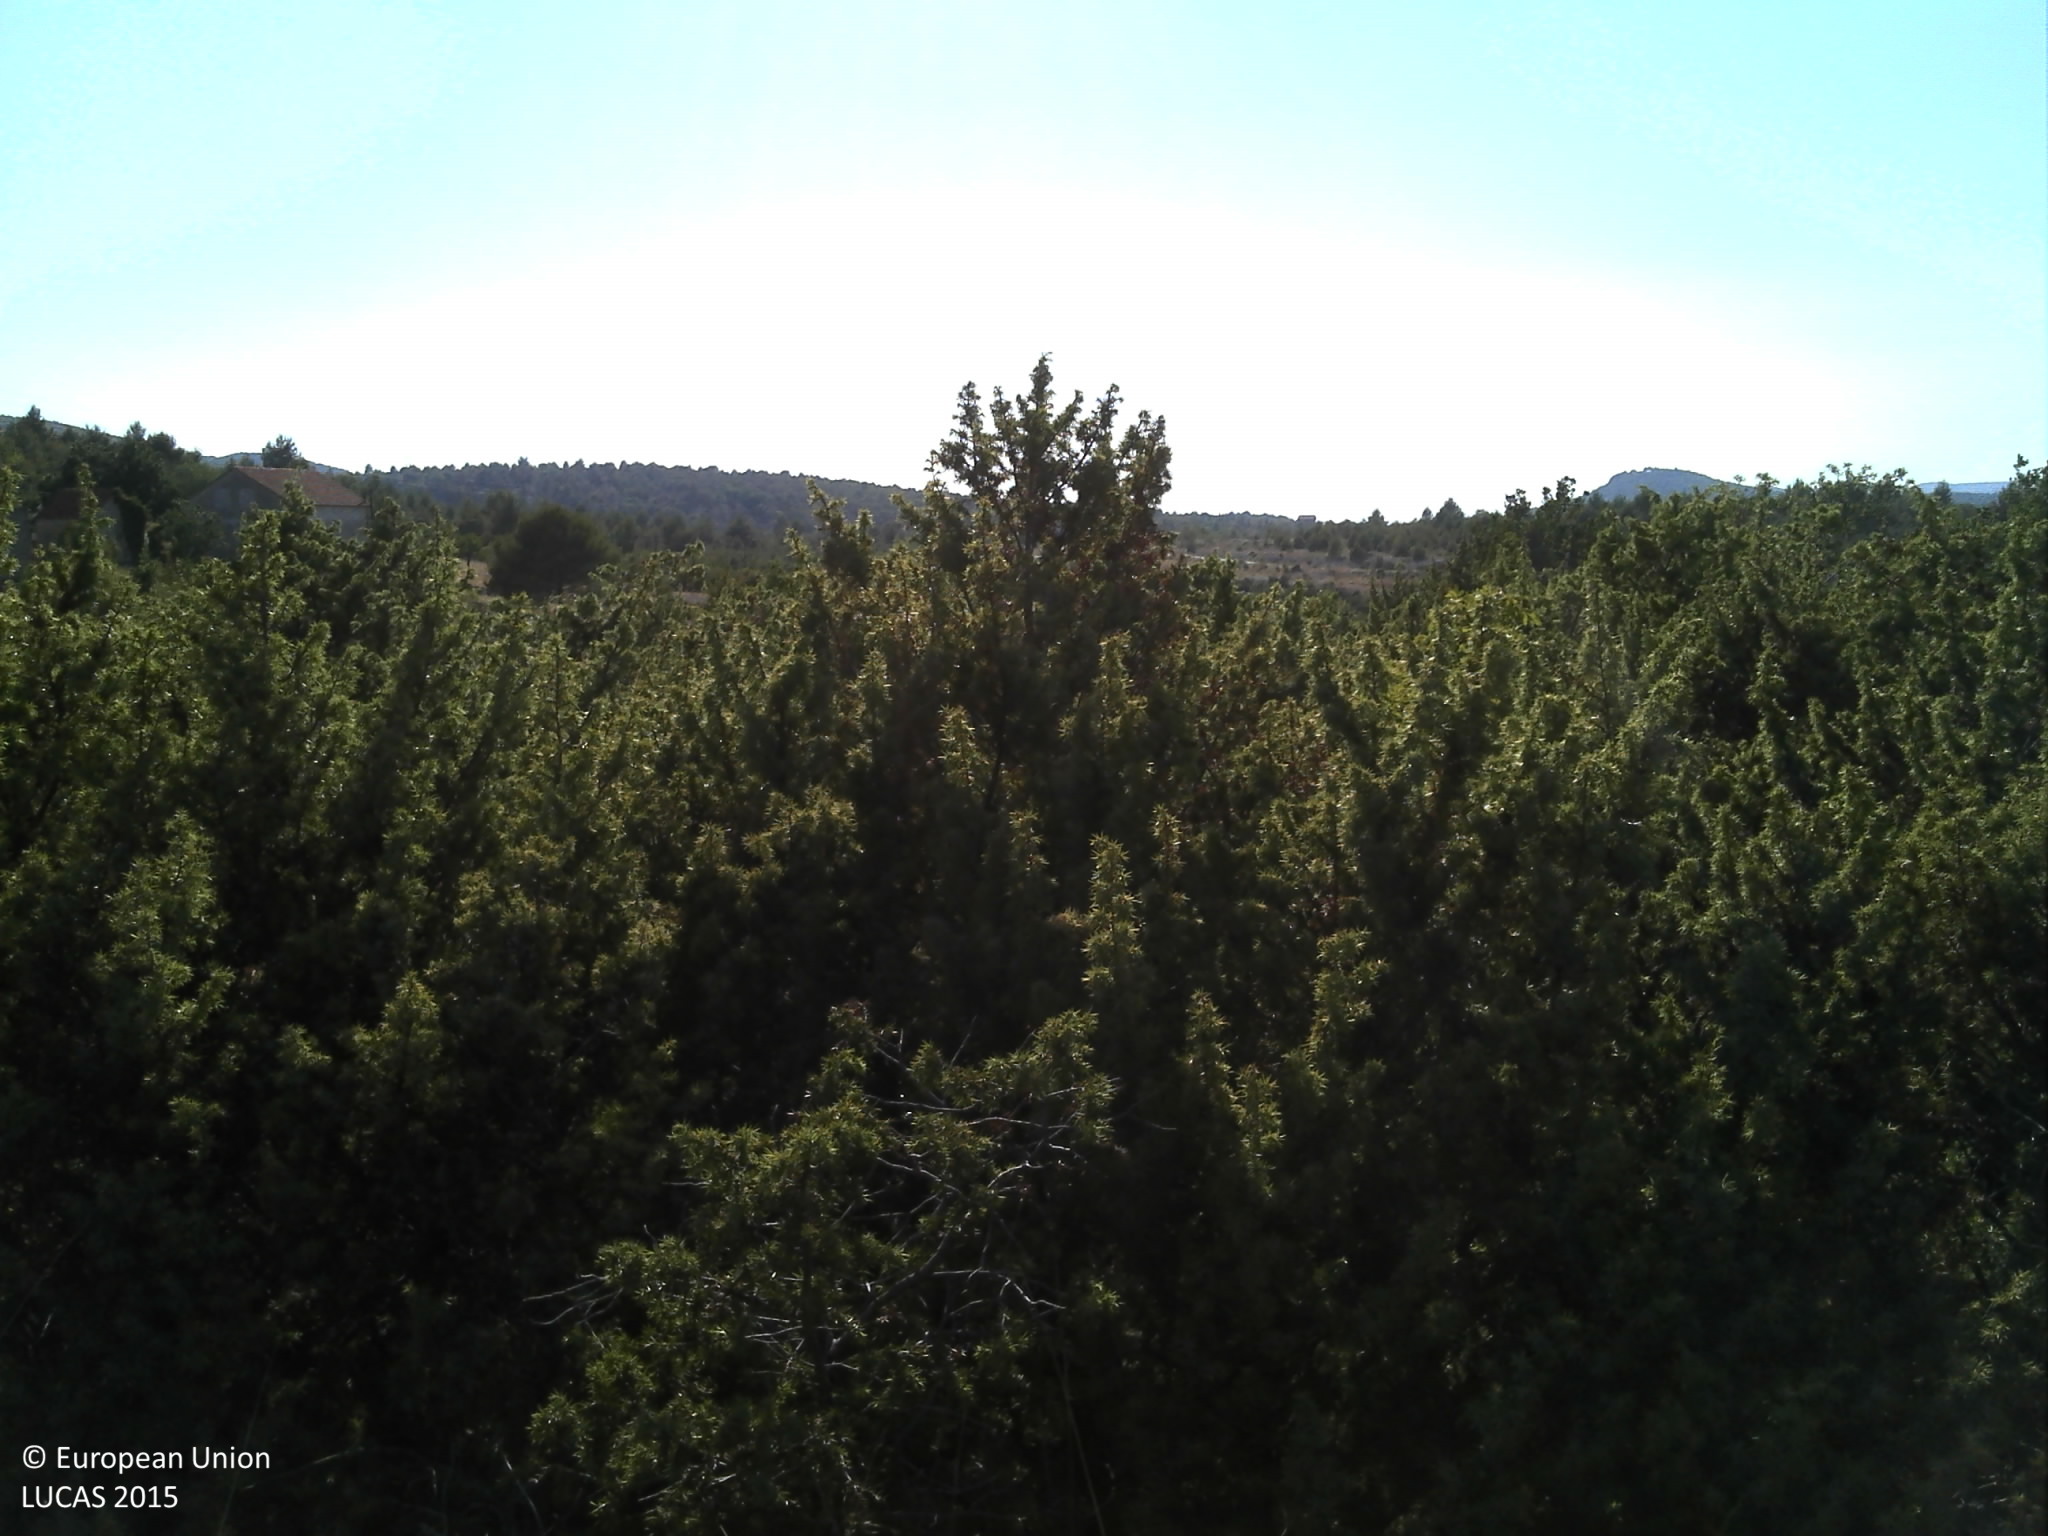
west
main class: Shrubland
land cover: Shrubland without tree cover
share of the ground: 50 - 75 %
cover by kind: shrubs 60 %, herbaceous plants 20 %, consolidated bare surface 10 %, unconsolidated bare surface 10 %
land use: Semi-natural and natural areas not in use
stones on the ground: < 10 %
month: July
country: HR
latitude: 43.6673
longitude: 16.0554
